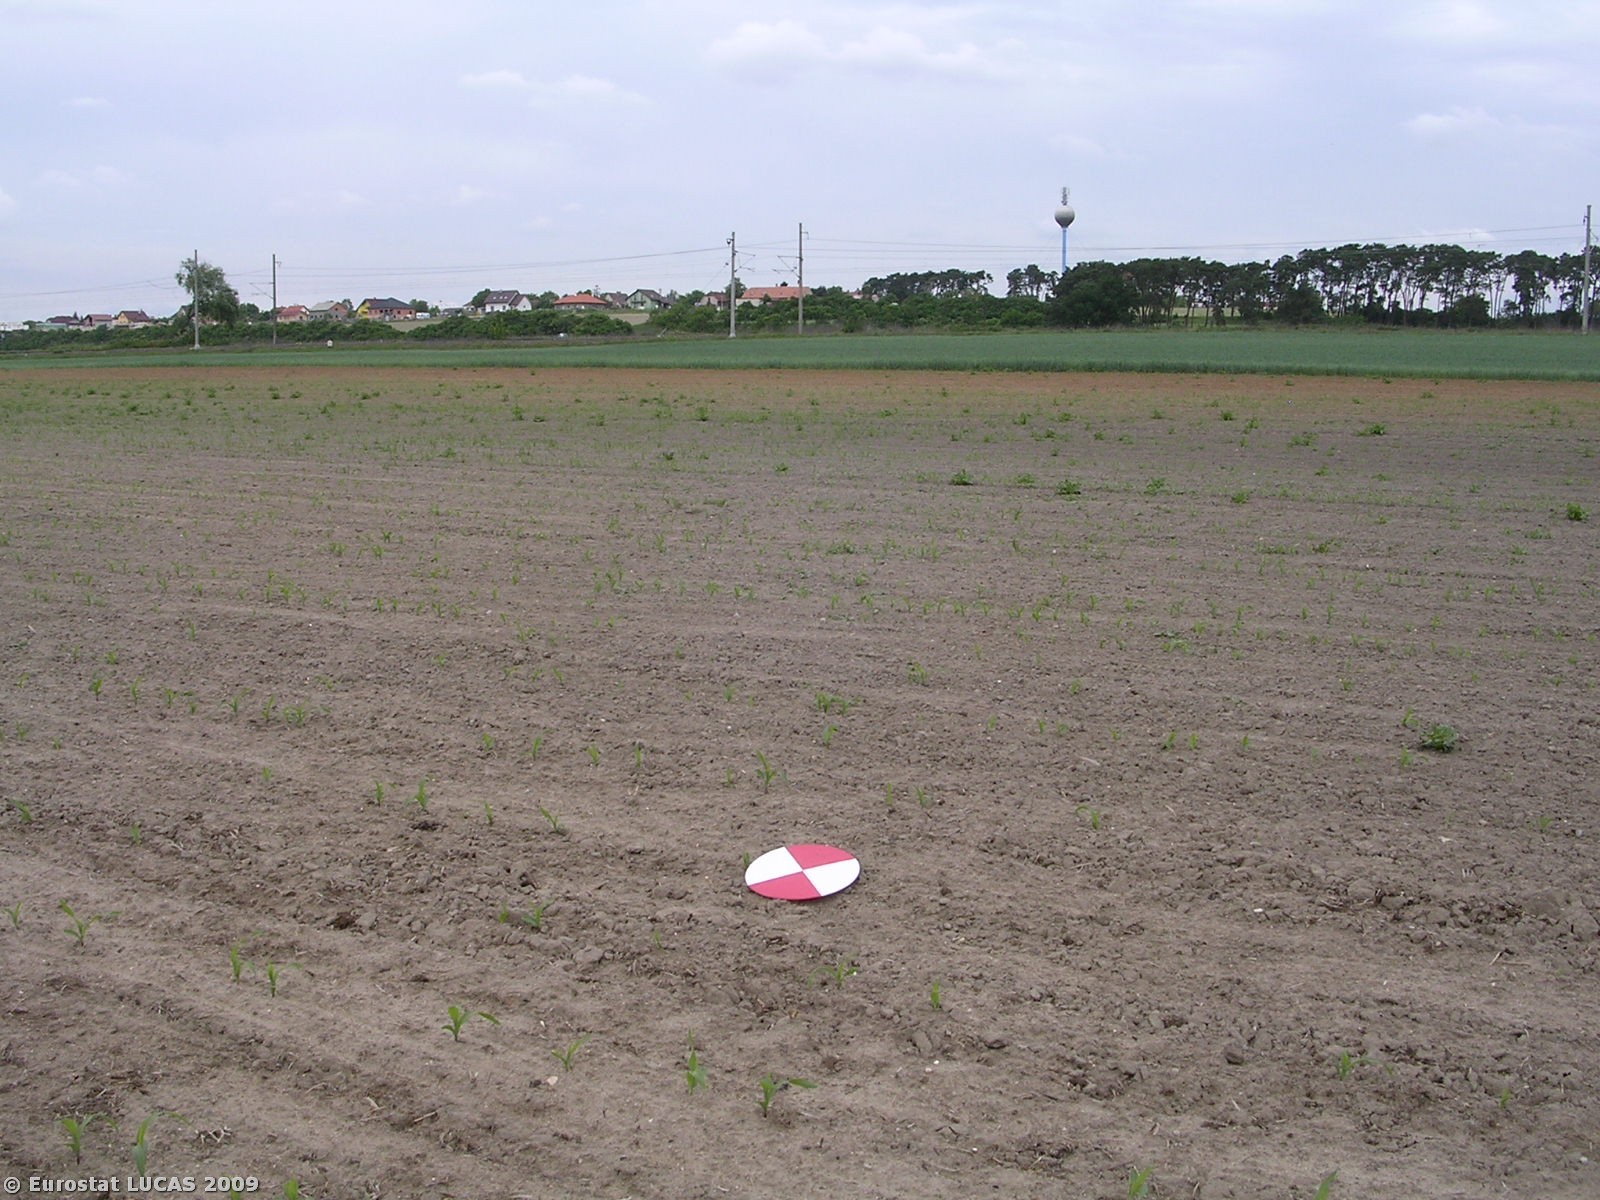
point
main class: Cropland
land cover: Maize
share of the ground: < 10 %
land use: Agriculture (excluding fallow land and kitchen gardens)
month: May
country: CZ
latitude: 50.1863
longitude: 14.9185
